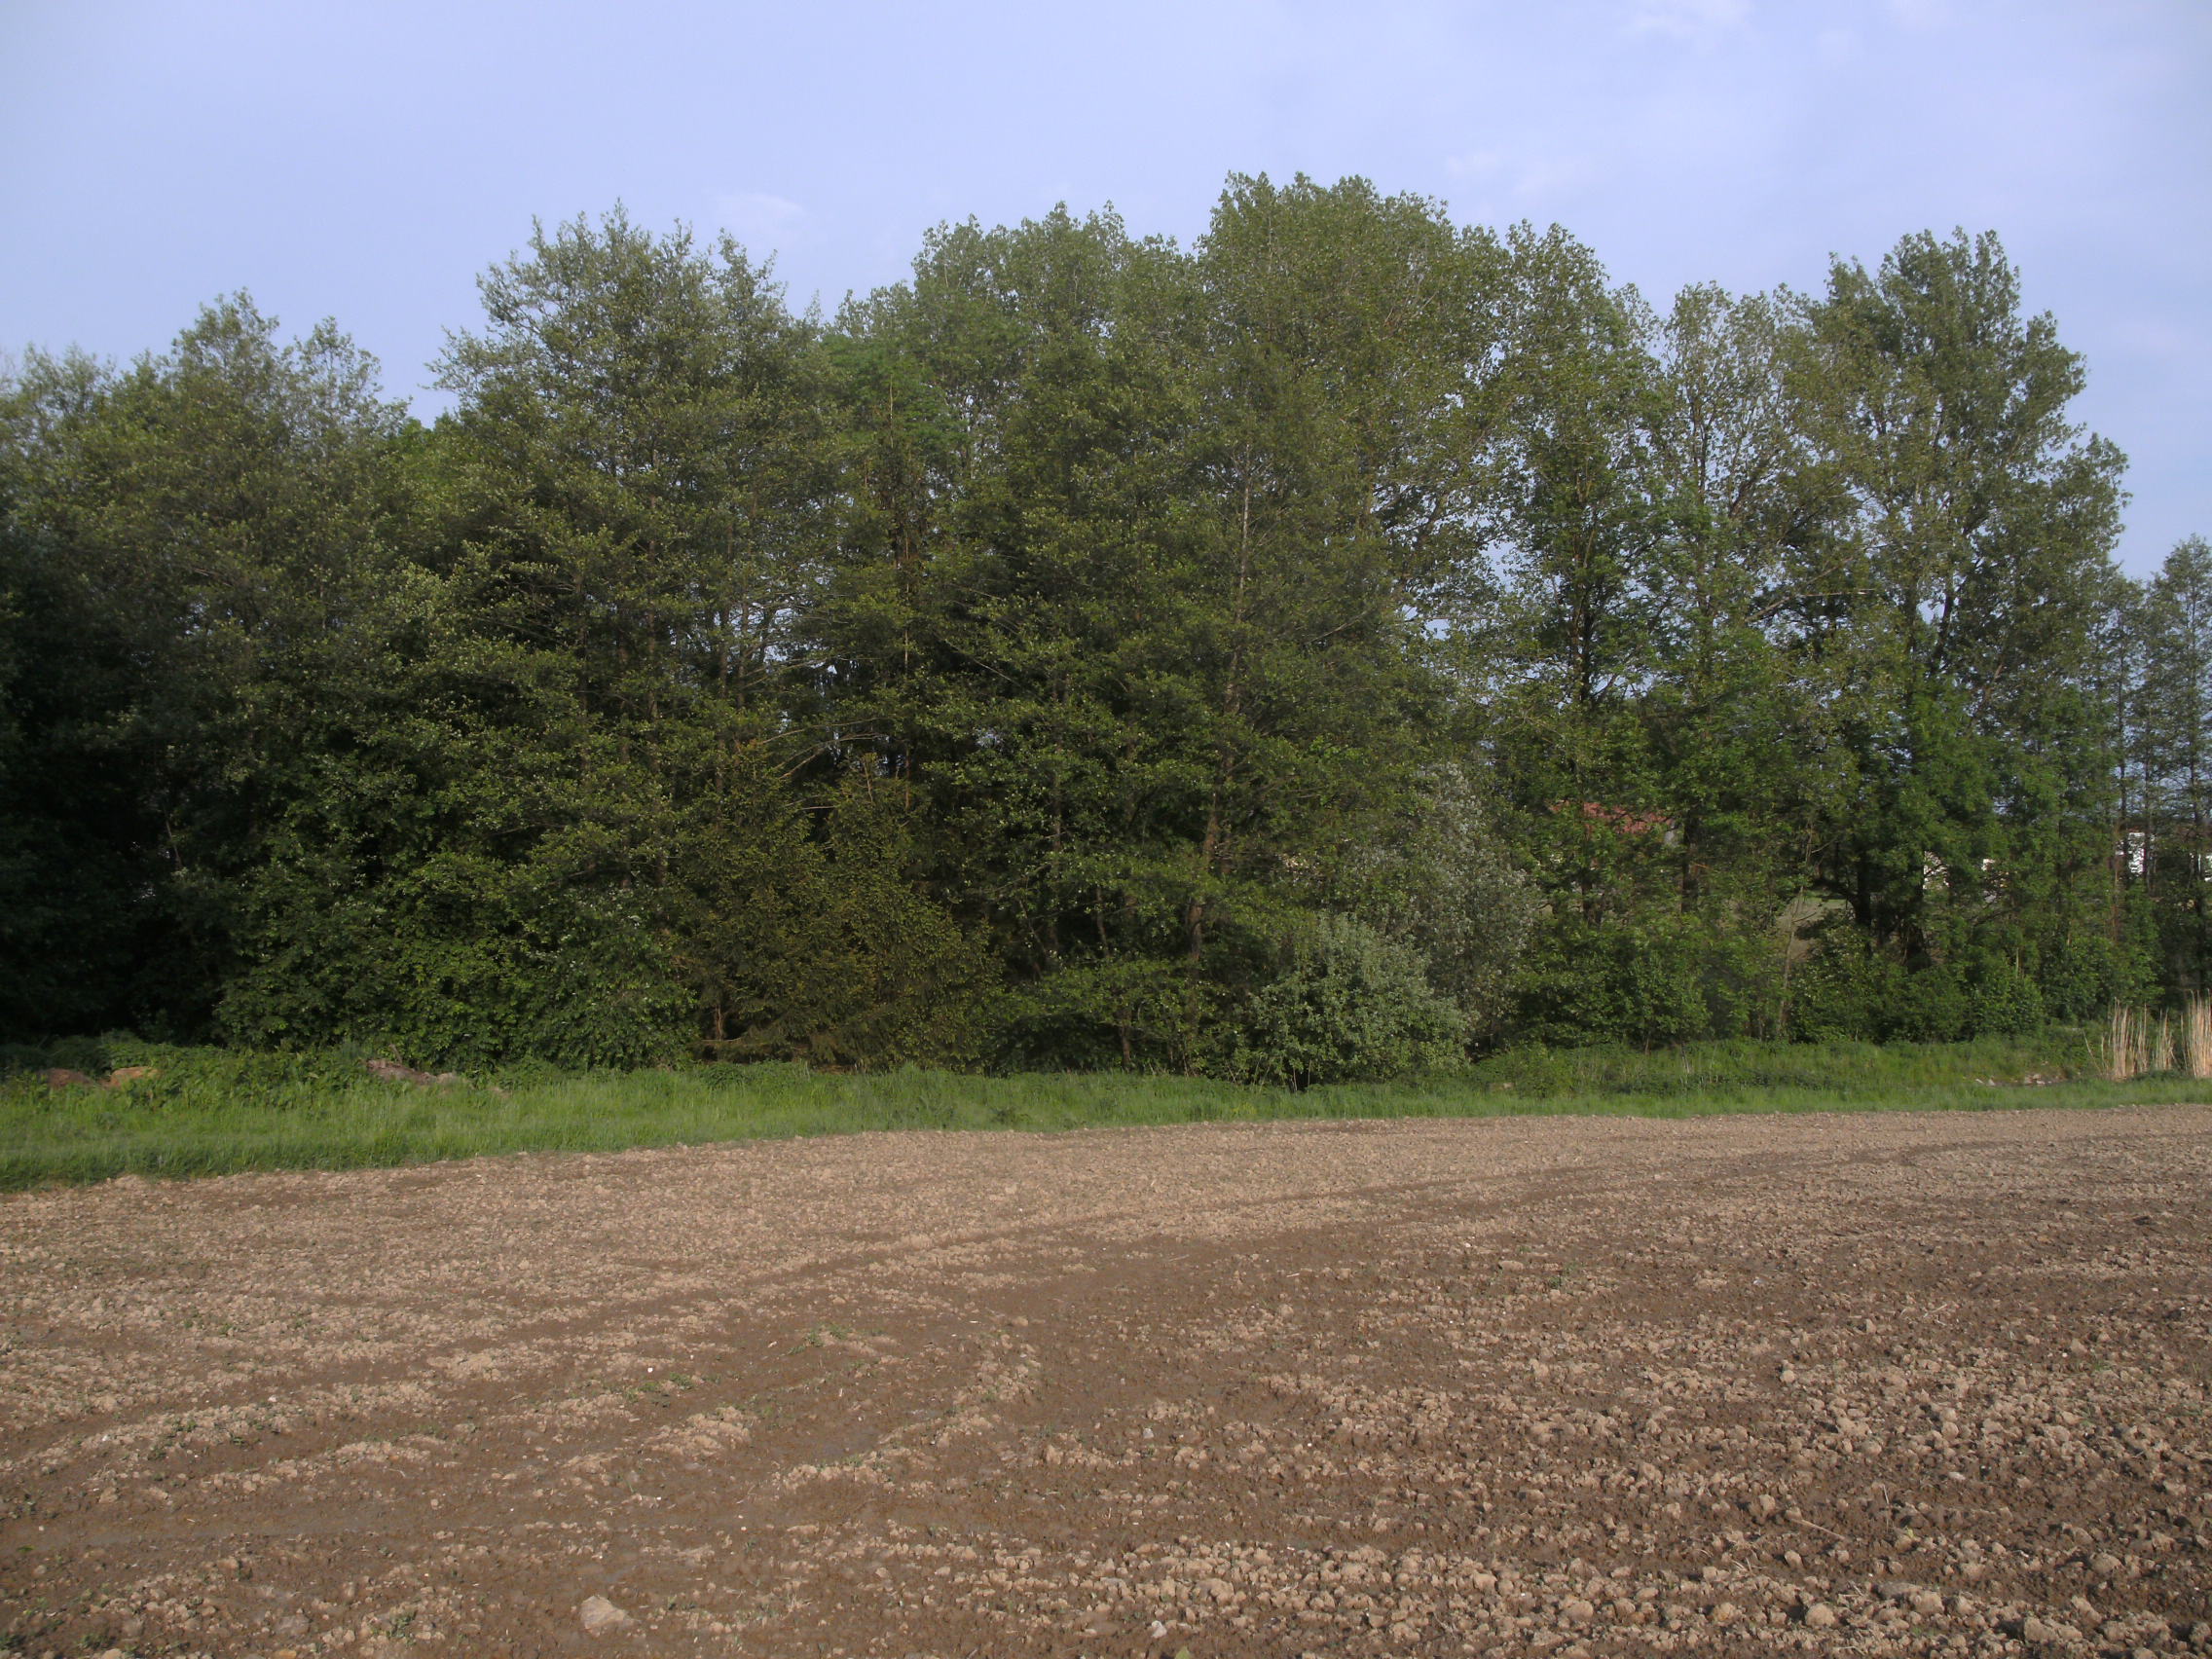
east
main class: Cropland
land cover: Soya
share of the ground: < 10 %
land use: Agriculture (excluding fallow land and kitchen gardens)
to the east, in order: Soya; Grass margins; Tracks; Spontaneously vegetated surfaces; Spruce dominated mixed woodland; Rivers and streams; Spruce dominated mixed woodland; Rivers and streams; Broadleaved woodland; Pear fruit; Artificial constructions in urban areas; Maize; Grass margins; Electric lines; Apple fruit; Paved roads, cycling and walking lanes; Grass margins; Ditches and canals; Grassland without tree/shrub cover; Maize
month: May
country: AT
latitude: 48.3583
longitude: 13.7380
